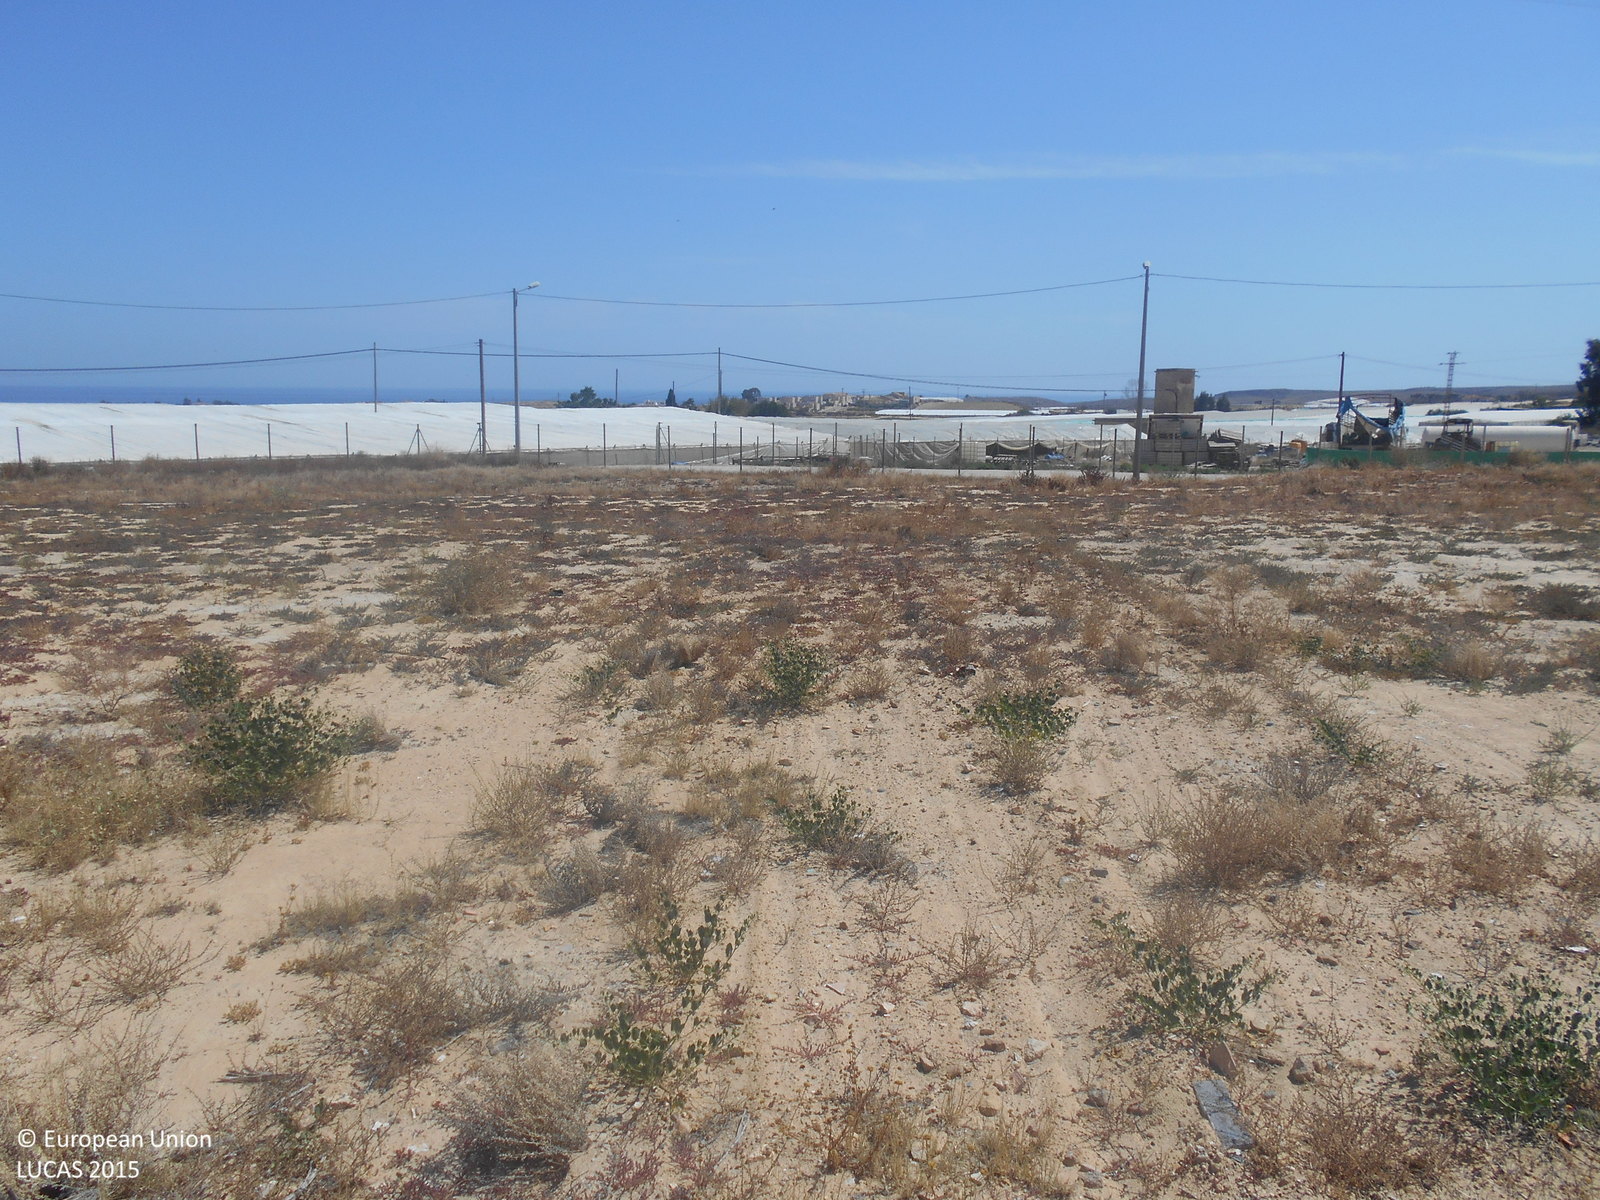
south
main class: Grassland
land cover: Spontaneously vegetated surfaces
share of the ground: 25 - 50 %
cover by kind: unconsolidated bare surface 60 %, herbaceous plants 35 %, shrubs 5 %
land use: Abandoned areas
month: May
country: ES
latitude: 37.5562
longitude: -1.3788
